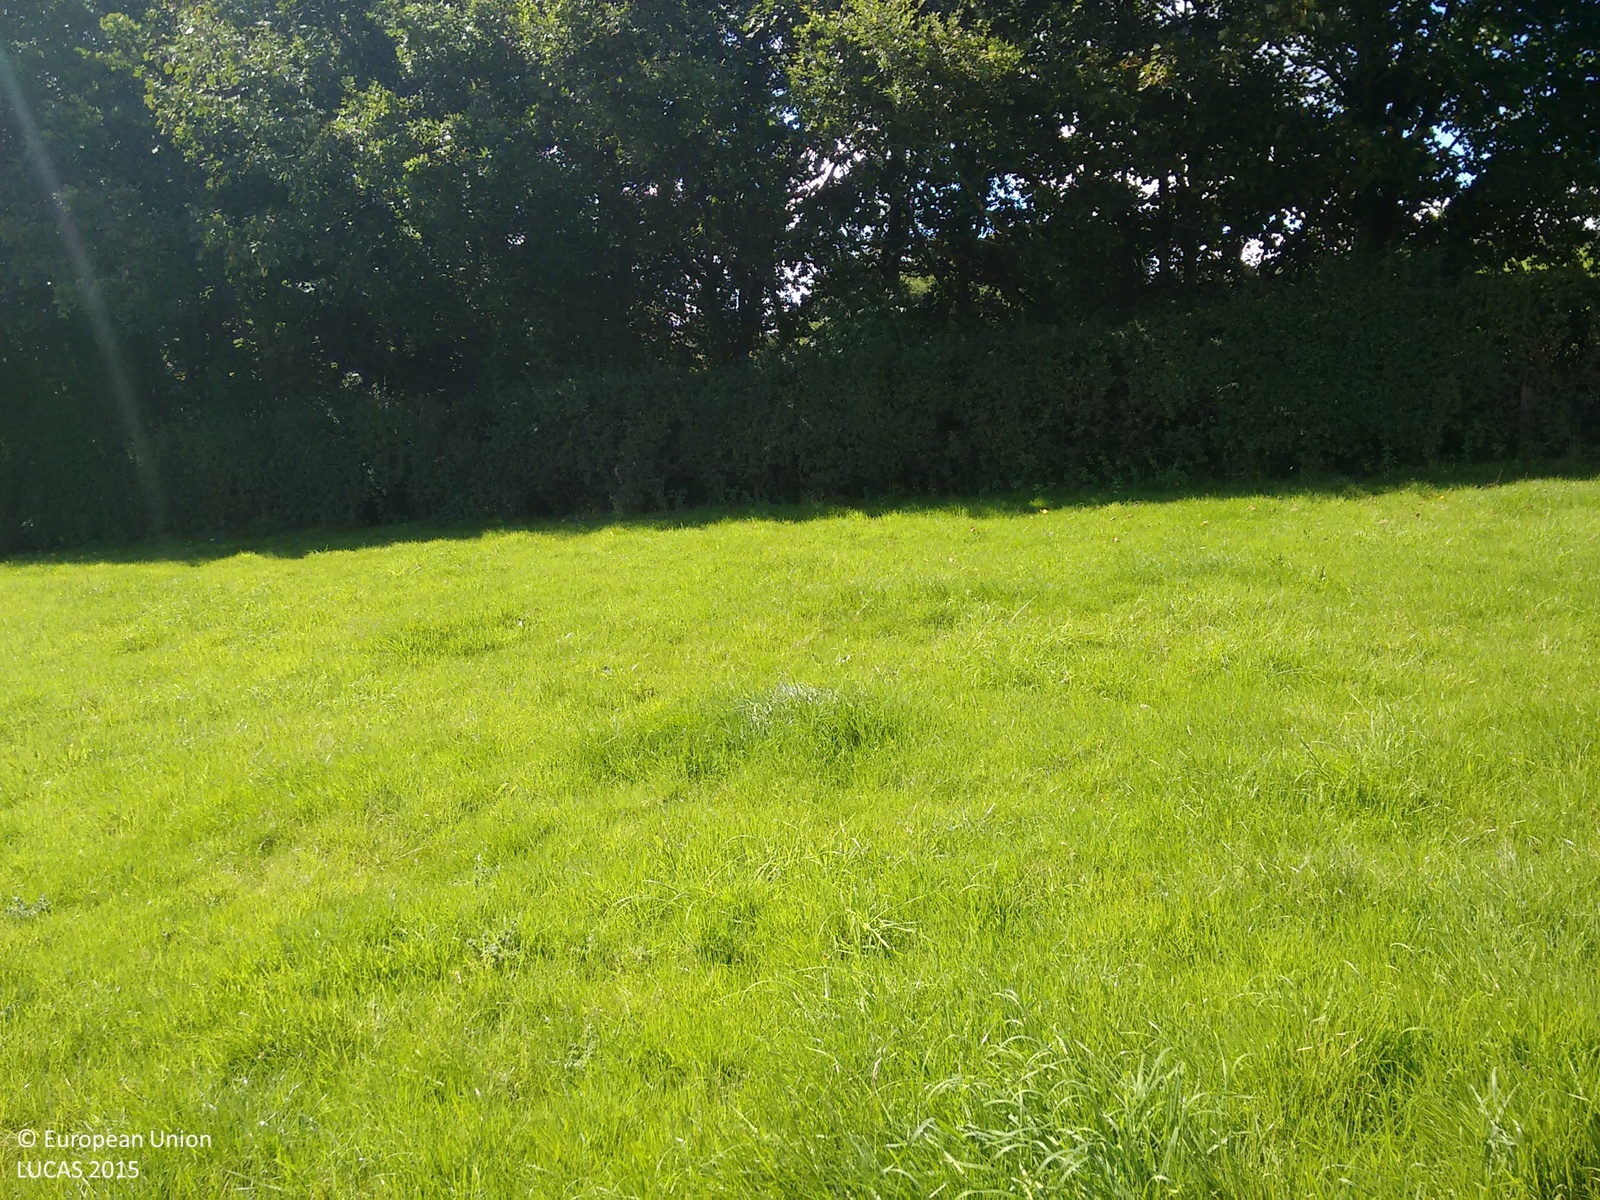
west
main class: Grassland
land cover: Grassland without tree/shrub cover
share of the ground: > 75 %
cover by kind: herbaceous plants 100 %
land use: Agriculture (excluding fallow land and kitchen gardens)
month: September
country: GB
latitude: 50.5714
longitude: -4.3190
